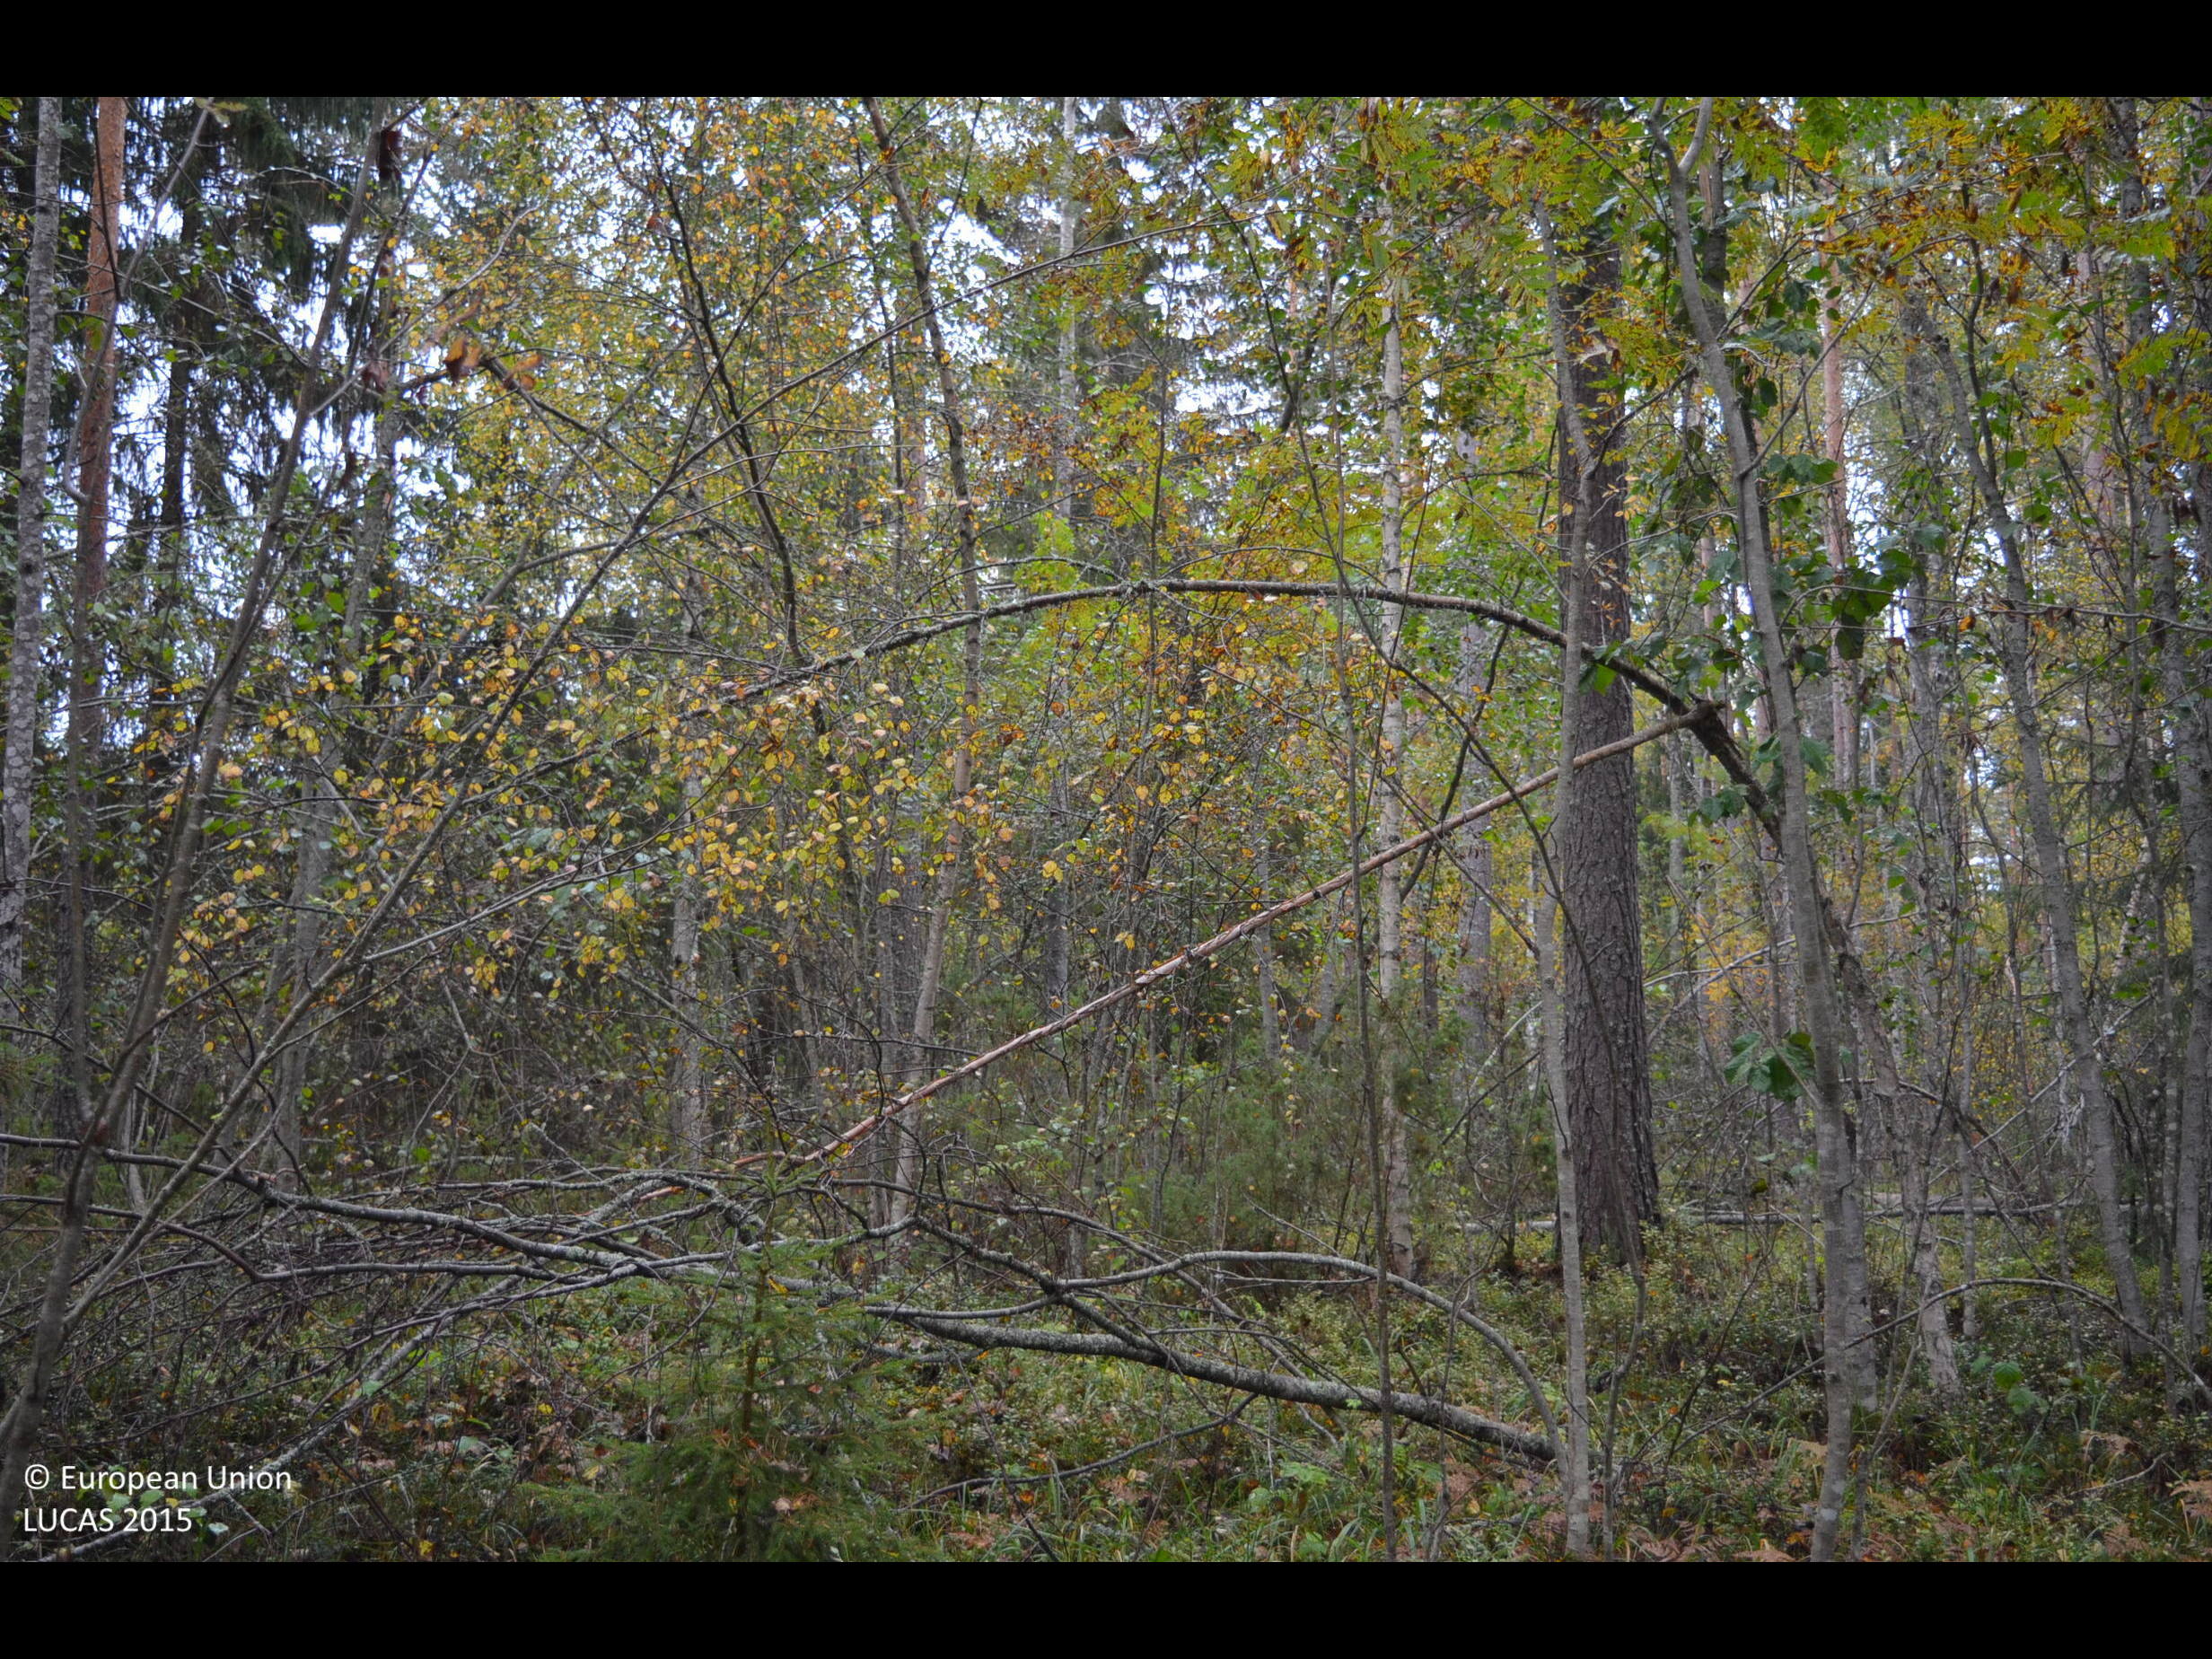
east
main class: Woodland
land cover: Other mixed woodland
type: boreal forest
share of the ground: > 75 %
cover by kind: coniferous forest trees 45 %, broadleaved forest trees 35 %, shrubs 15 %, herbaceous plants 5 %
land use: Forestry
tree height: > 5 m
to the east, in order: Other mixed woodland; Ditches and canals; Other mixed woodland; Pine dominated coniferous woodland
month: September
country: FI
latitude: 62.8079
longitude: 23.7042
